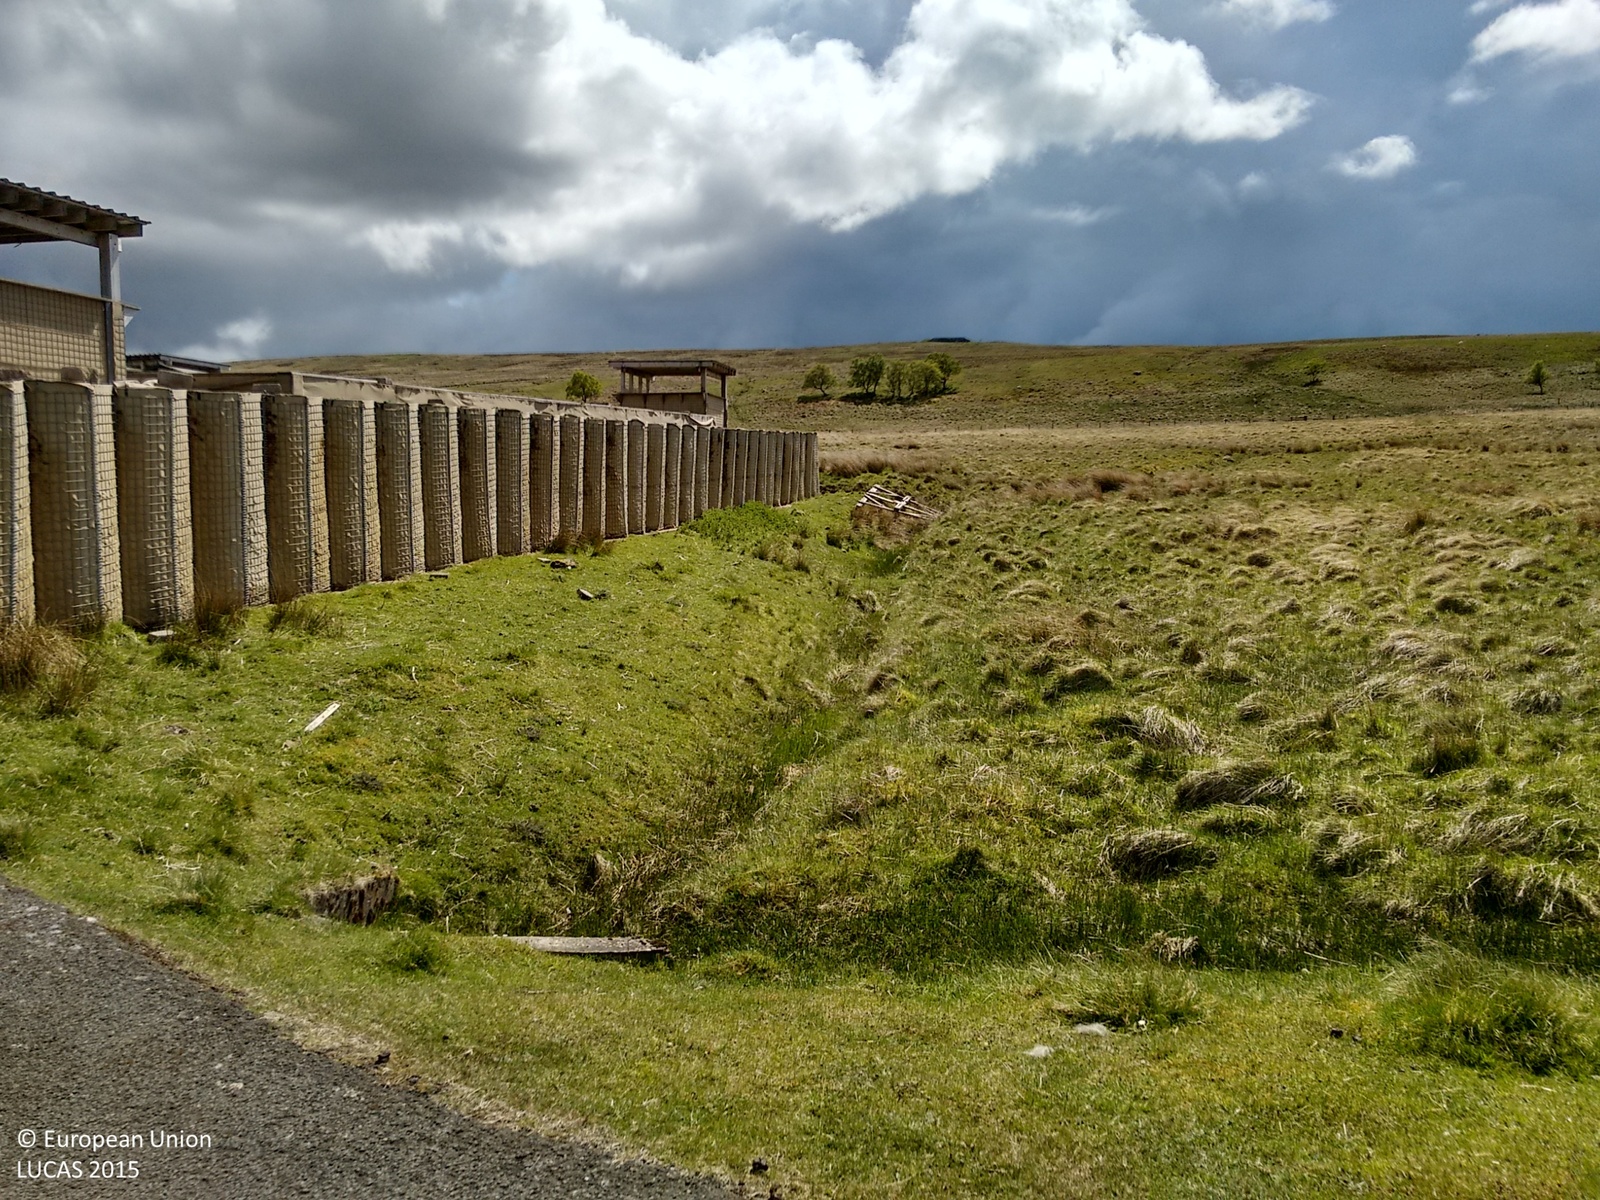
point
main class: Shrubland
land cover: Shrubland without tree cover
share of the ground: > 75 %
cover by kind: shrubs 80 %, herbaceous plants 20 %
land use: Agriculture (excluding fallow land and kitchen gardens)
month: May
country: GB
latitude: 55.3143
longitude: -2.1731
